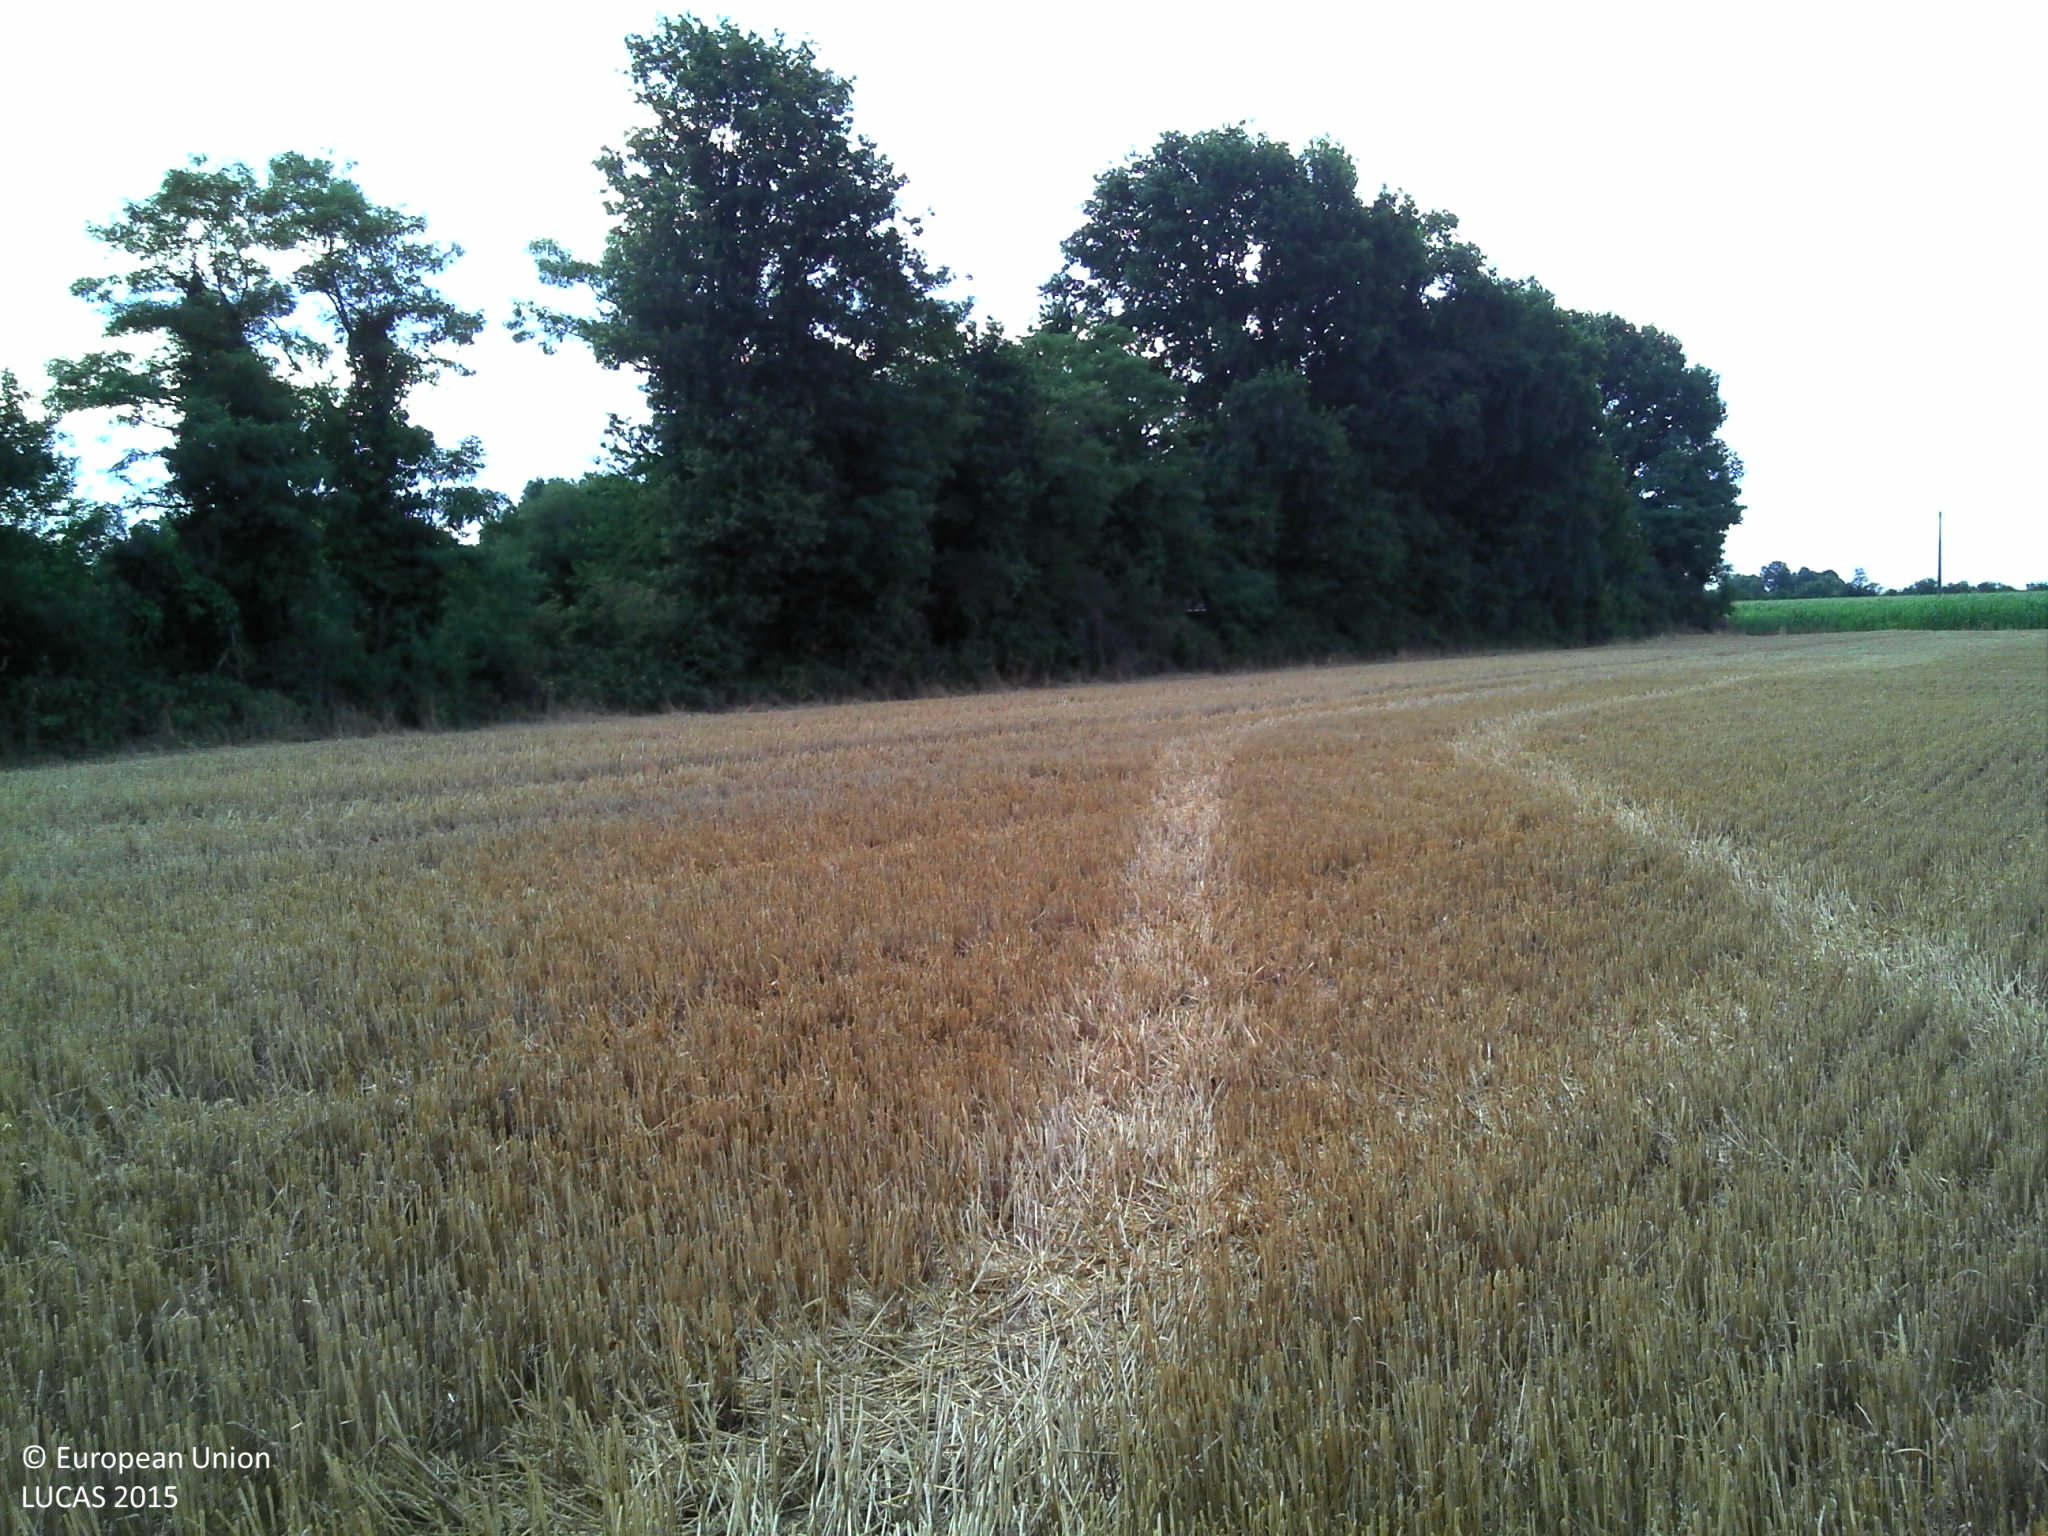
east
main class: Cropland
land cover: Common wheat
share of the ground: > 75 %
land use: Agriculture (excluding fallow land and kitchen gardens)
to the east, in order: Common wheat; Broadleaved woodland; Grassland without tree/shrub cover; Lines of trees; Inland fresh water bodies; Lines of trees; Grassland without tree/shrub cover; Broadleaved woodland; Maize
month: July
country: FR
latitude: 46.4982
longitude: 0.1946
